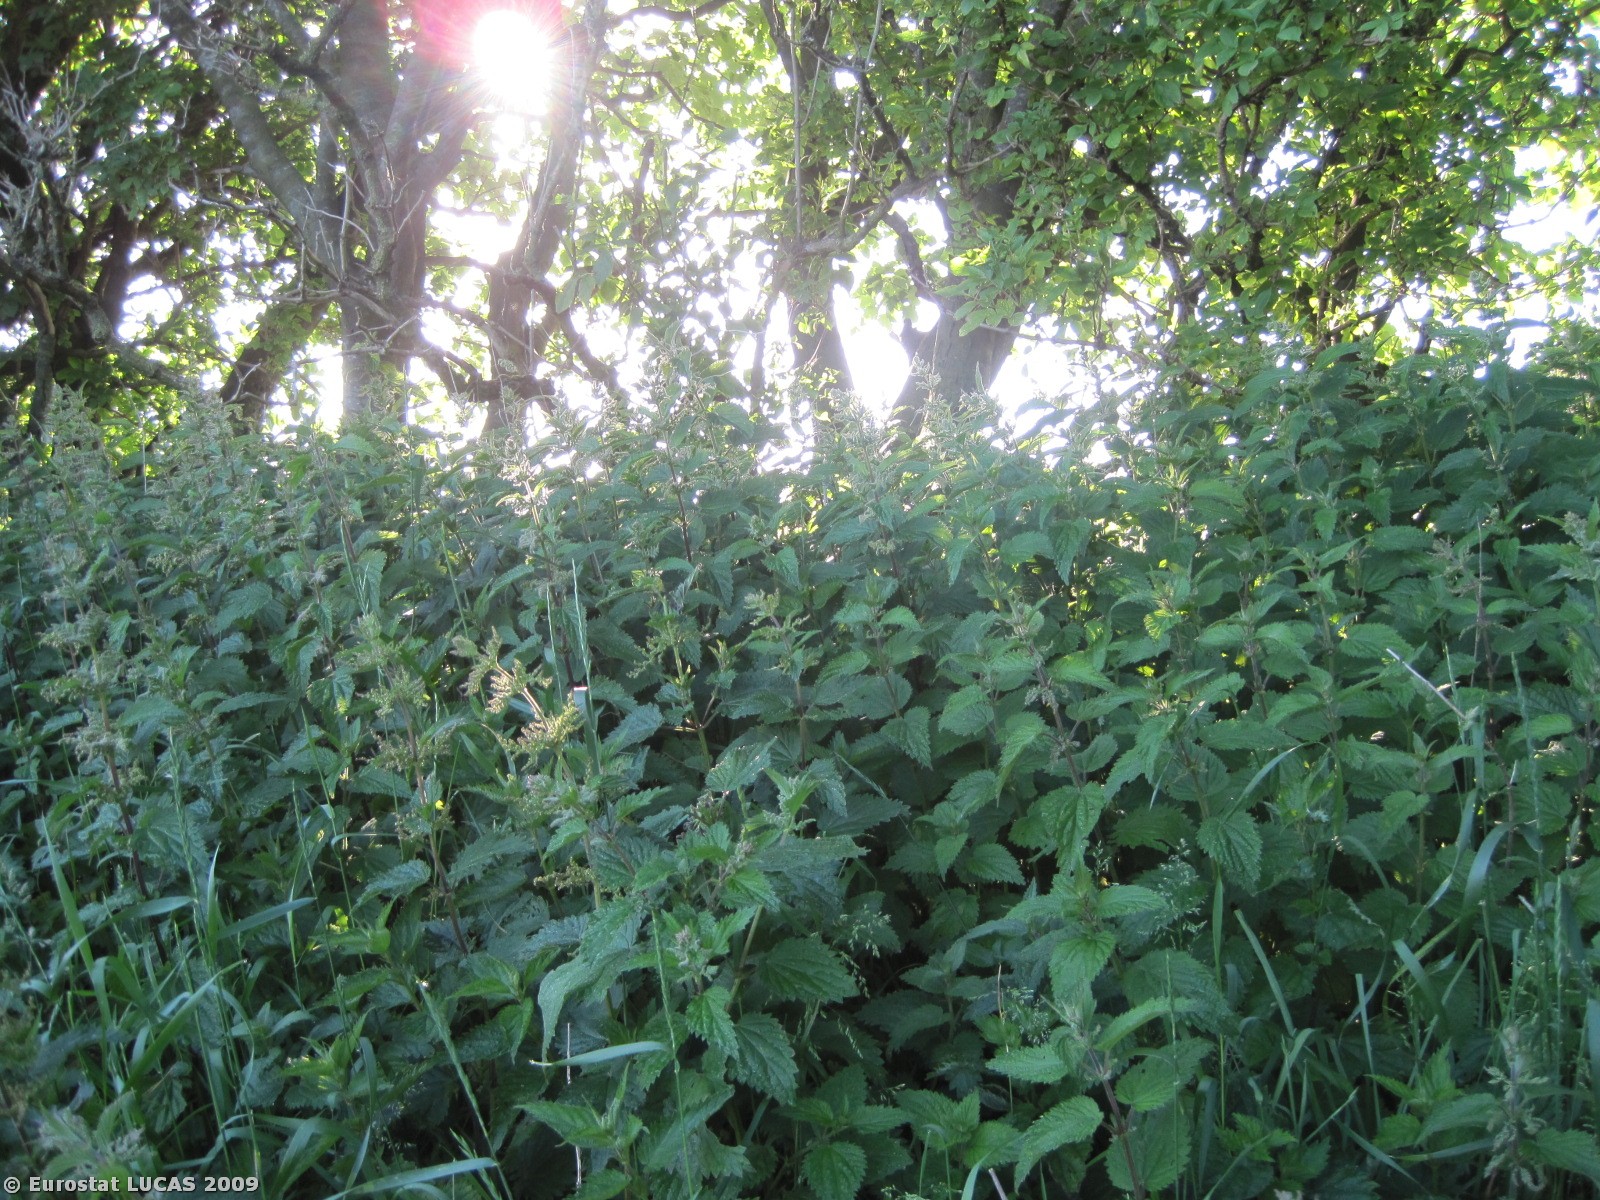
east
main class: Woodland
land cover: Broadleaved woodland
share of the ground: > 75 %
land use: Unused
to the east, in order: Grassland without tree/shrub cover; Broadleaved woodland; Grass margins; Barley; Grass margins; Broadleaved woodland; Barley
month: June
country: DK
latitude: 57.1764
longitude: 10.1486
